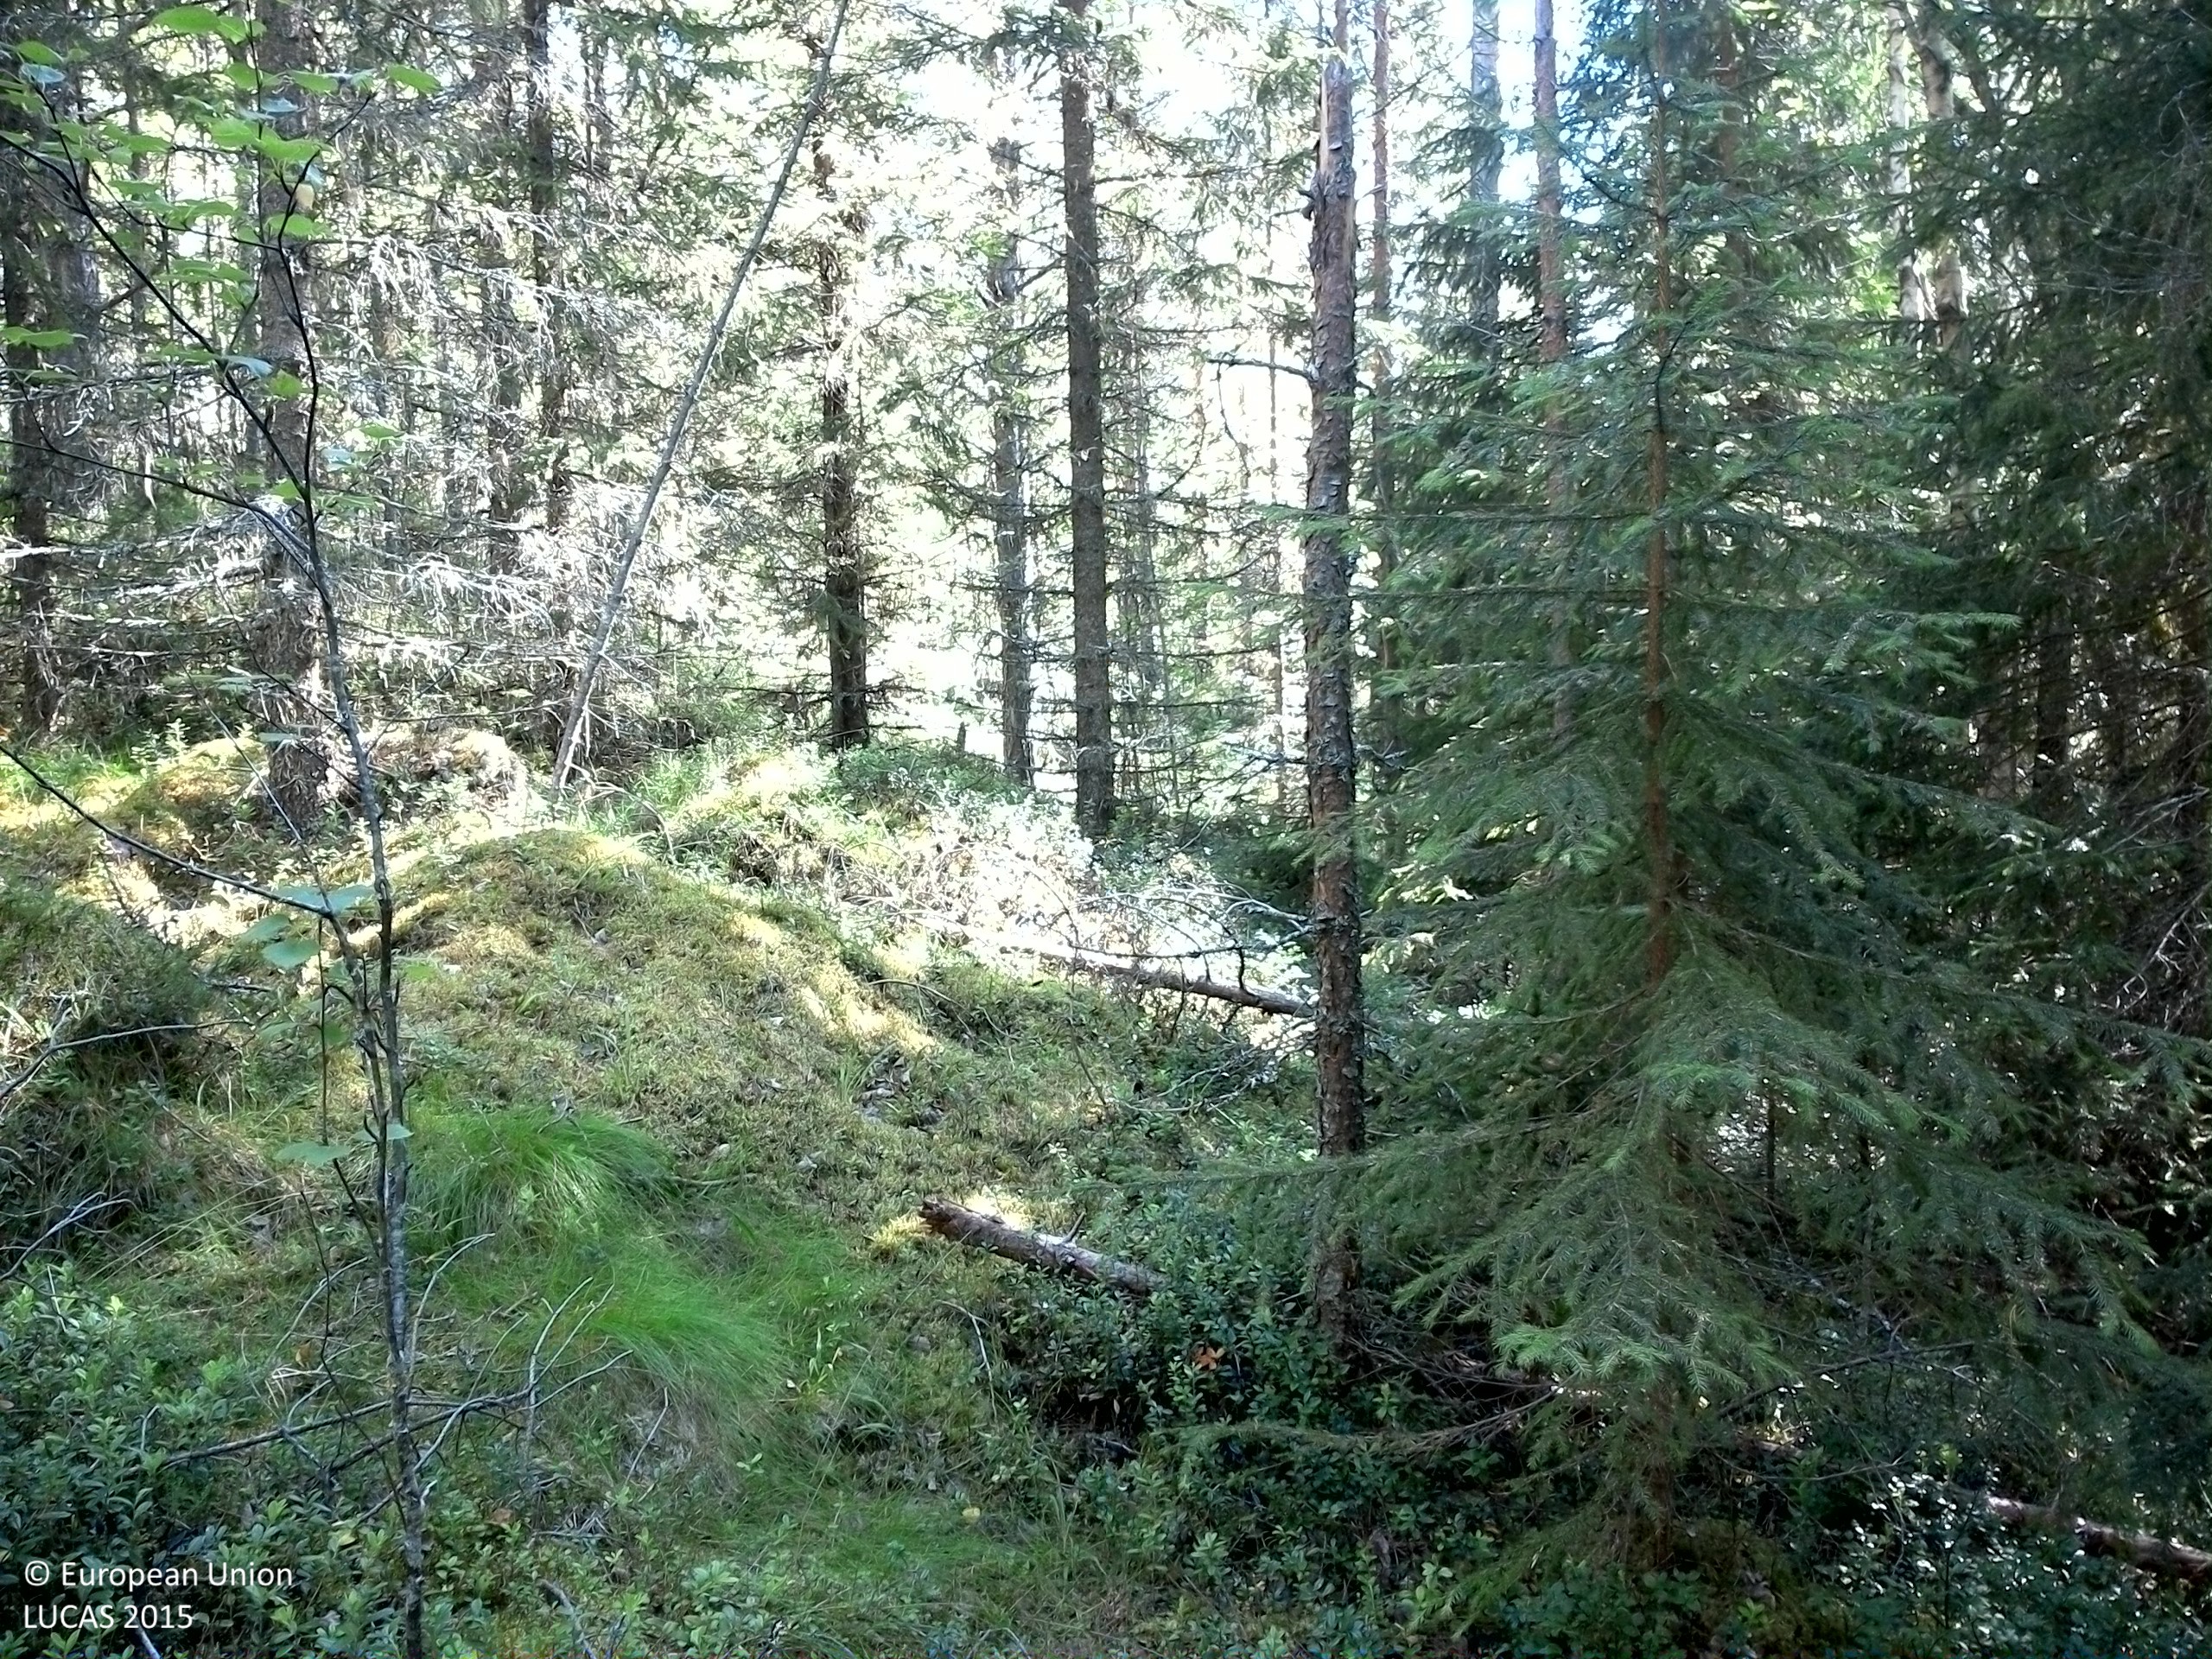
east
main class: Woodland
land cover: Pine dominated mixed woodland
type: boreal forest
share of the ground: 50 - 75 %
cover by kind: coniferous forest trees 45 %, shrubs 25 %, broadleaved forest trees 15 %, lichens and mosses 10 %, herbaceous plants 5 %
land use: Forestry
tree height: > 5 m
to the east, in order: Pine dominated mixed woodland; Tracks; Pine dominated coniferous woodland
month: August
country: SE
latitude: 63.7259
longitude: 16.3911
